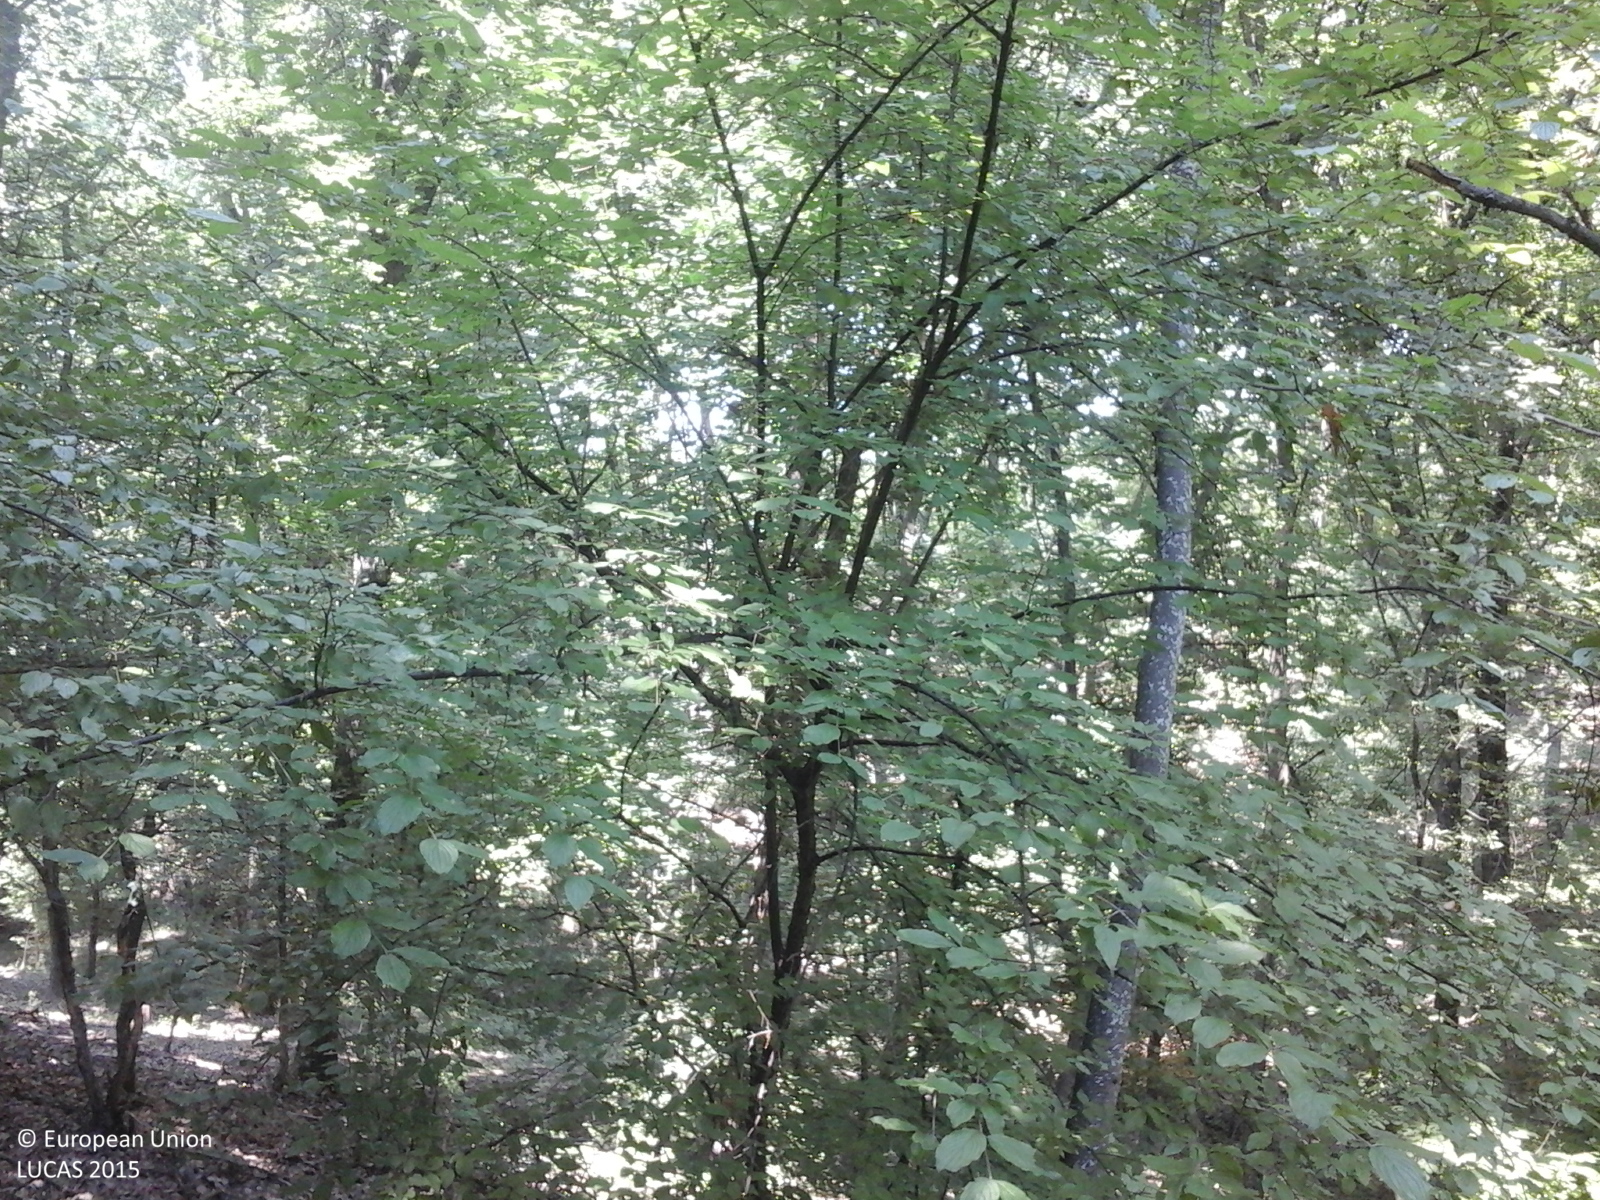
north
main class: Woodland
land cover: Broadleaved woodland
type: beech forest
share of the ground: > 75 %
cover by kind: broadleaved forest trees 100 %
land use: Forestry
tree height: > 5 m
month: July
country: RO
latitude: 44.7408
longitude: 24.4569
